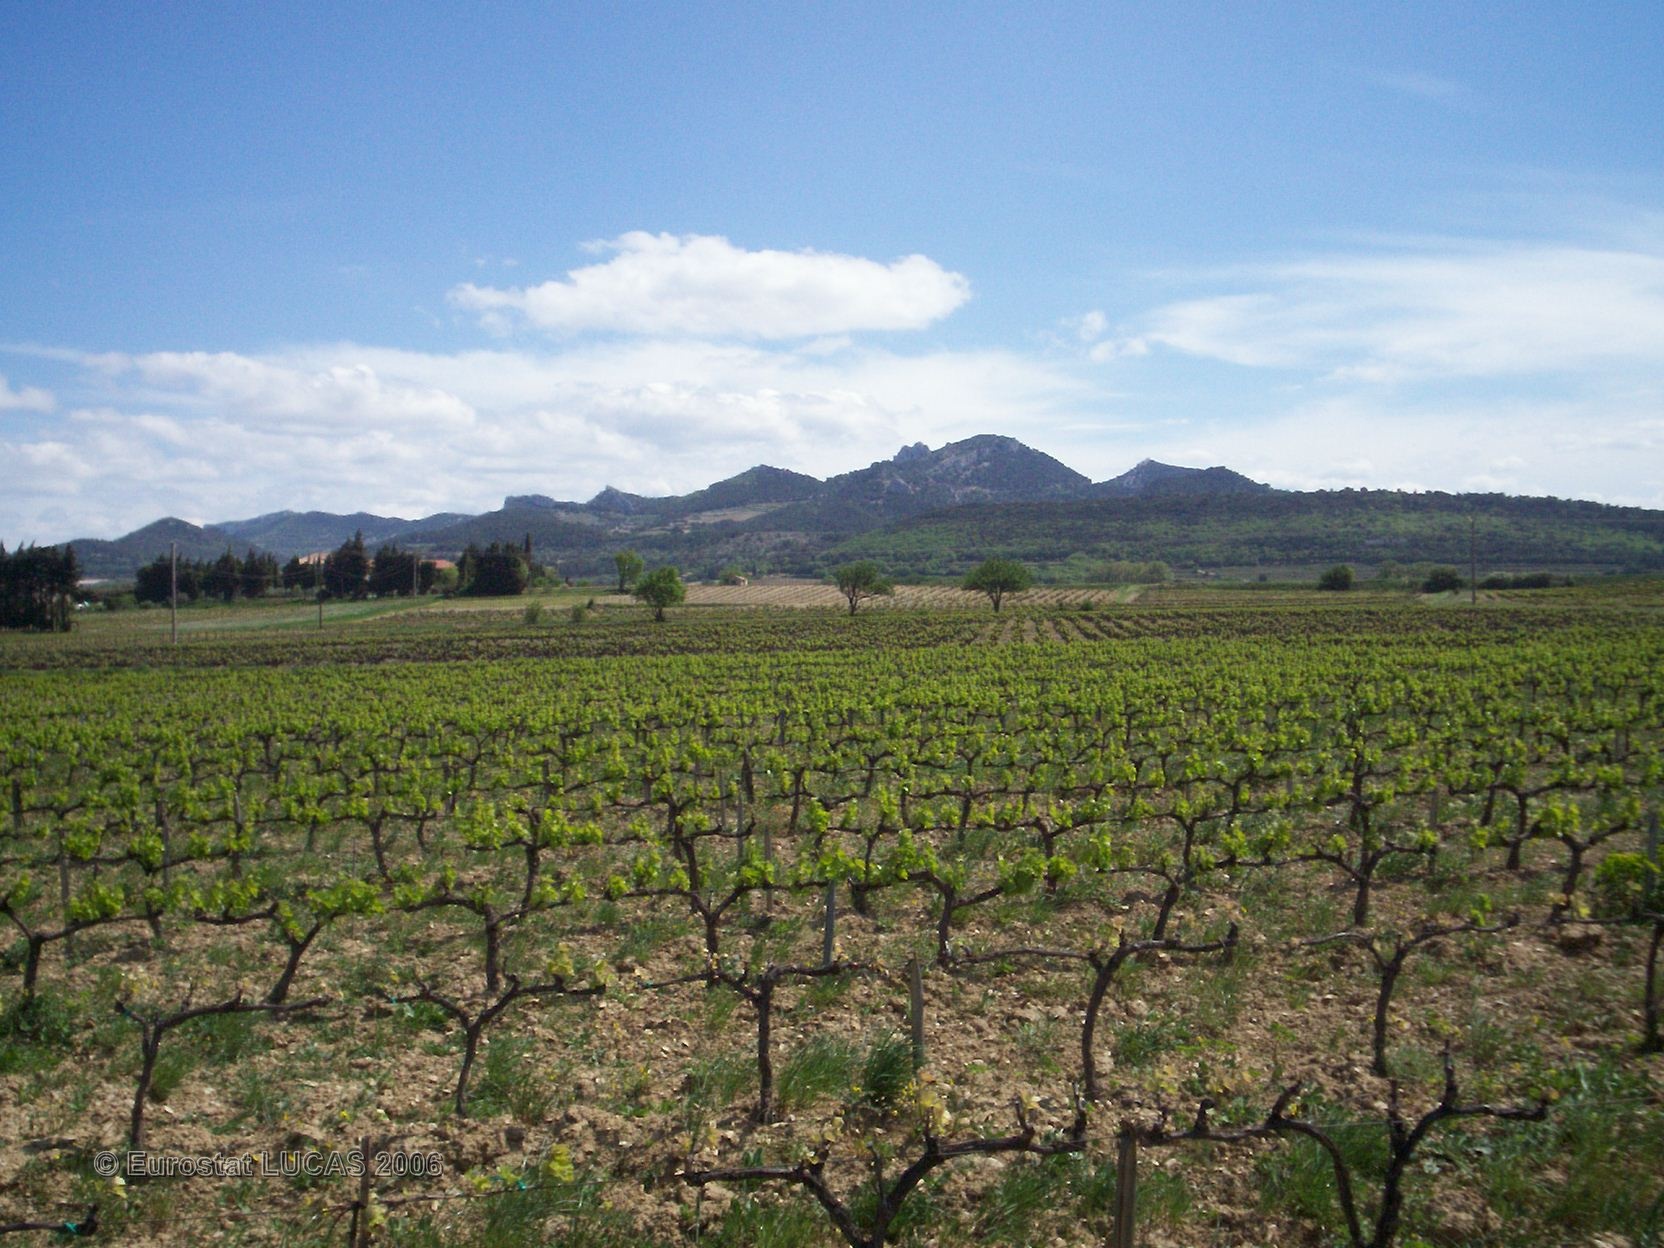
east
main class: Cropland
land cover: Vineyards
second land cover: Grassland with sparse tree/shrub cover
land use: Agriculture (excluding fallow land and kitchen gardens)
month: April
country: FR
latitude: 44.1563
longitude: 4.9690
